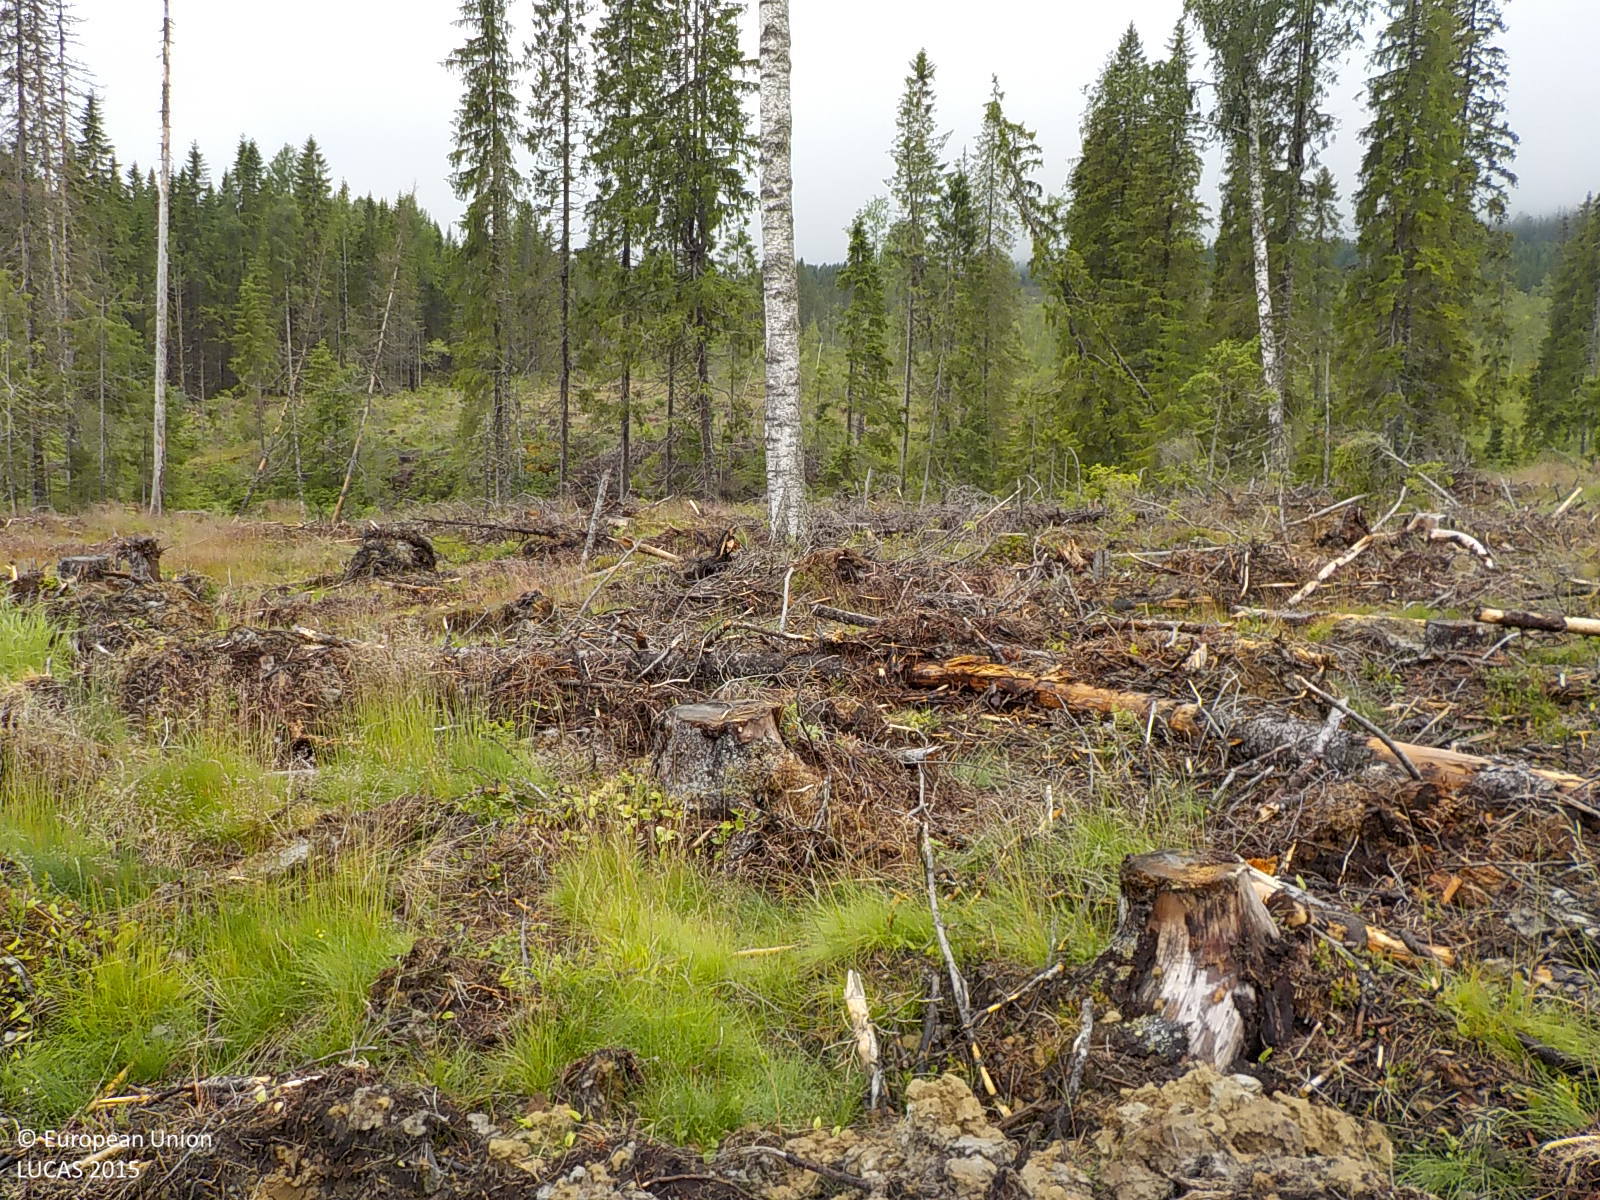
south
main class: Grassland
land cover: Grassland with sparse tree/shrub cover
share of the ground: 50 - 75 %
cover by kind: herbaceous plants 55 %, coniferous forest trees 5 %, shrubs 5 %, unconsolidated bare surface 5 %
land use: Forestry
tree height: < 5 m
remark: Clear cut
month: July
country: SE
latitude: 63.1437
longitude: 18.3312
